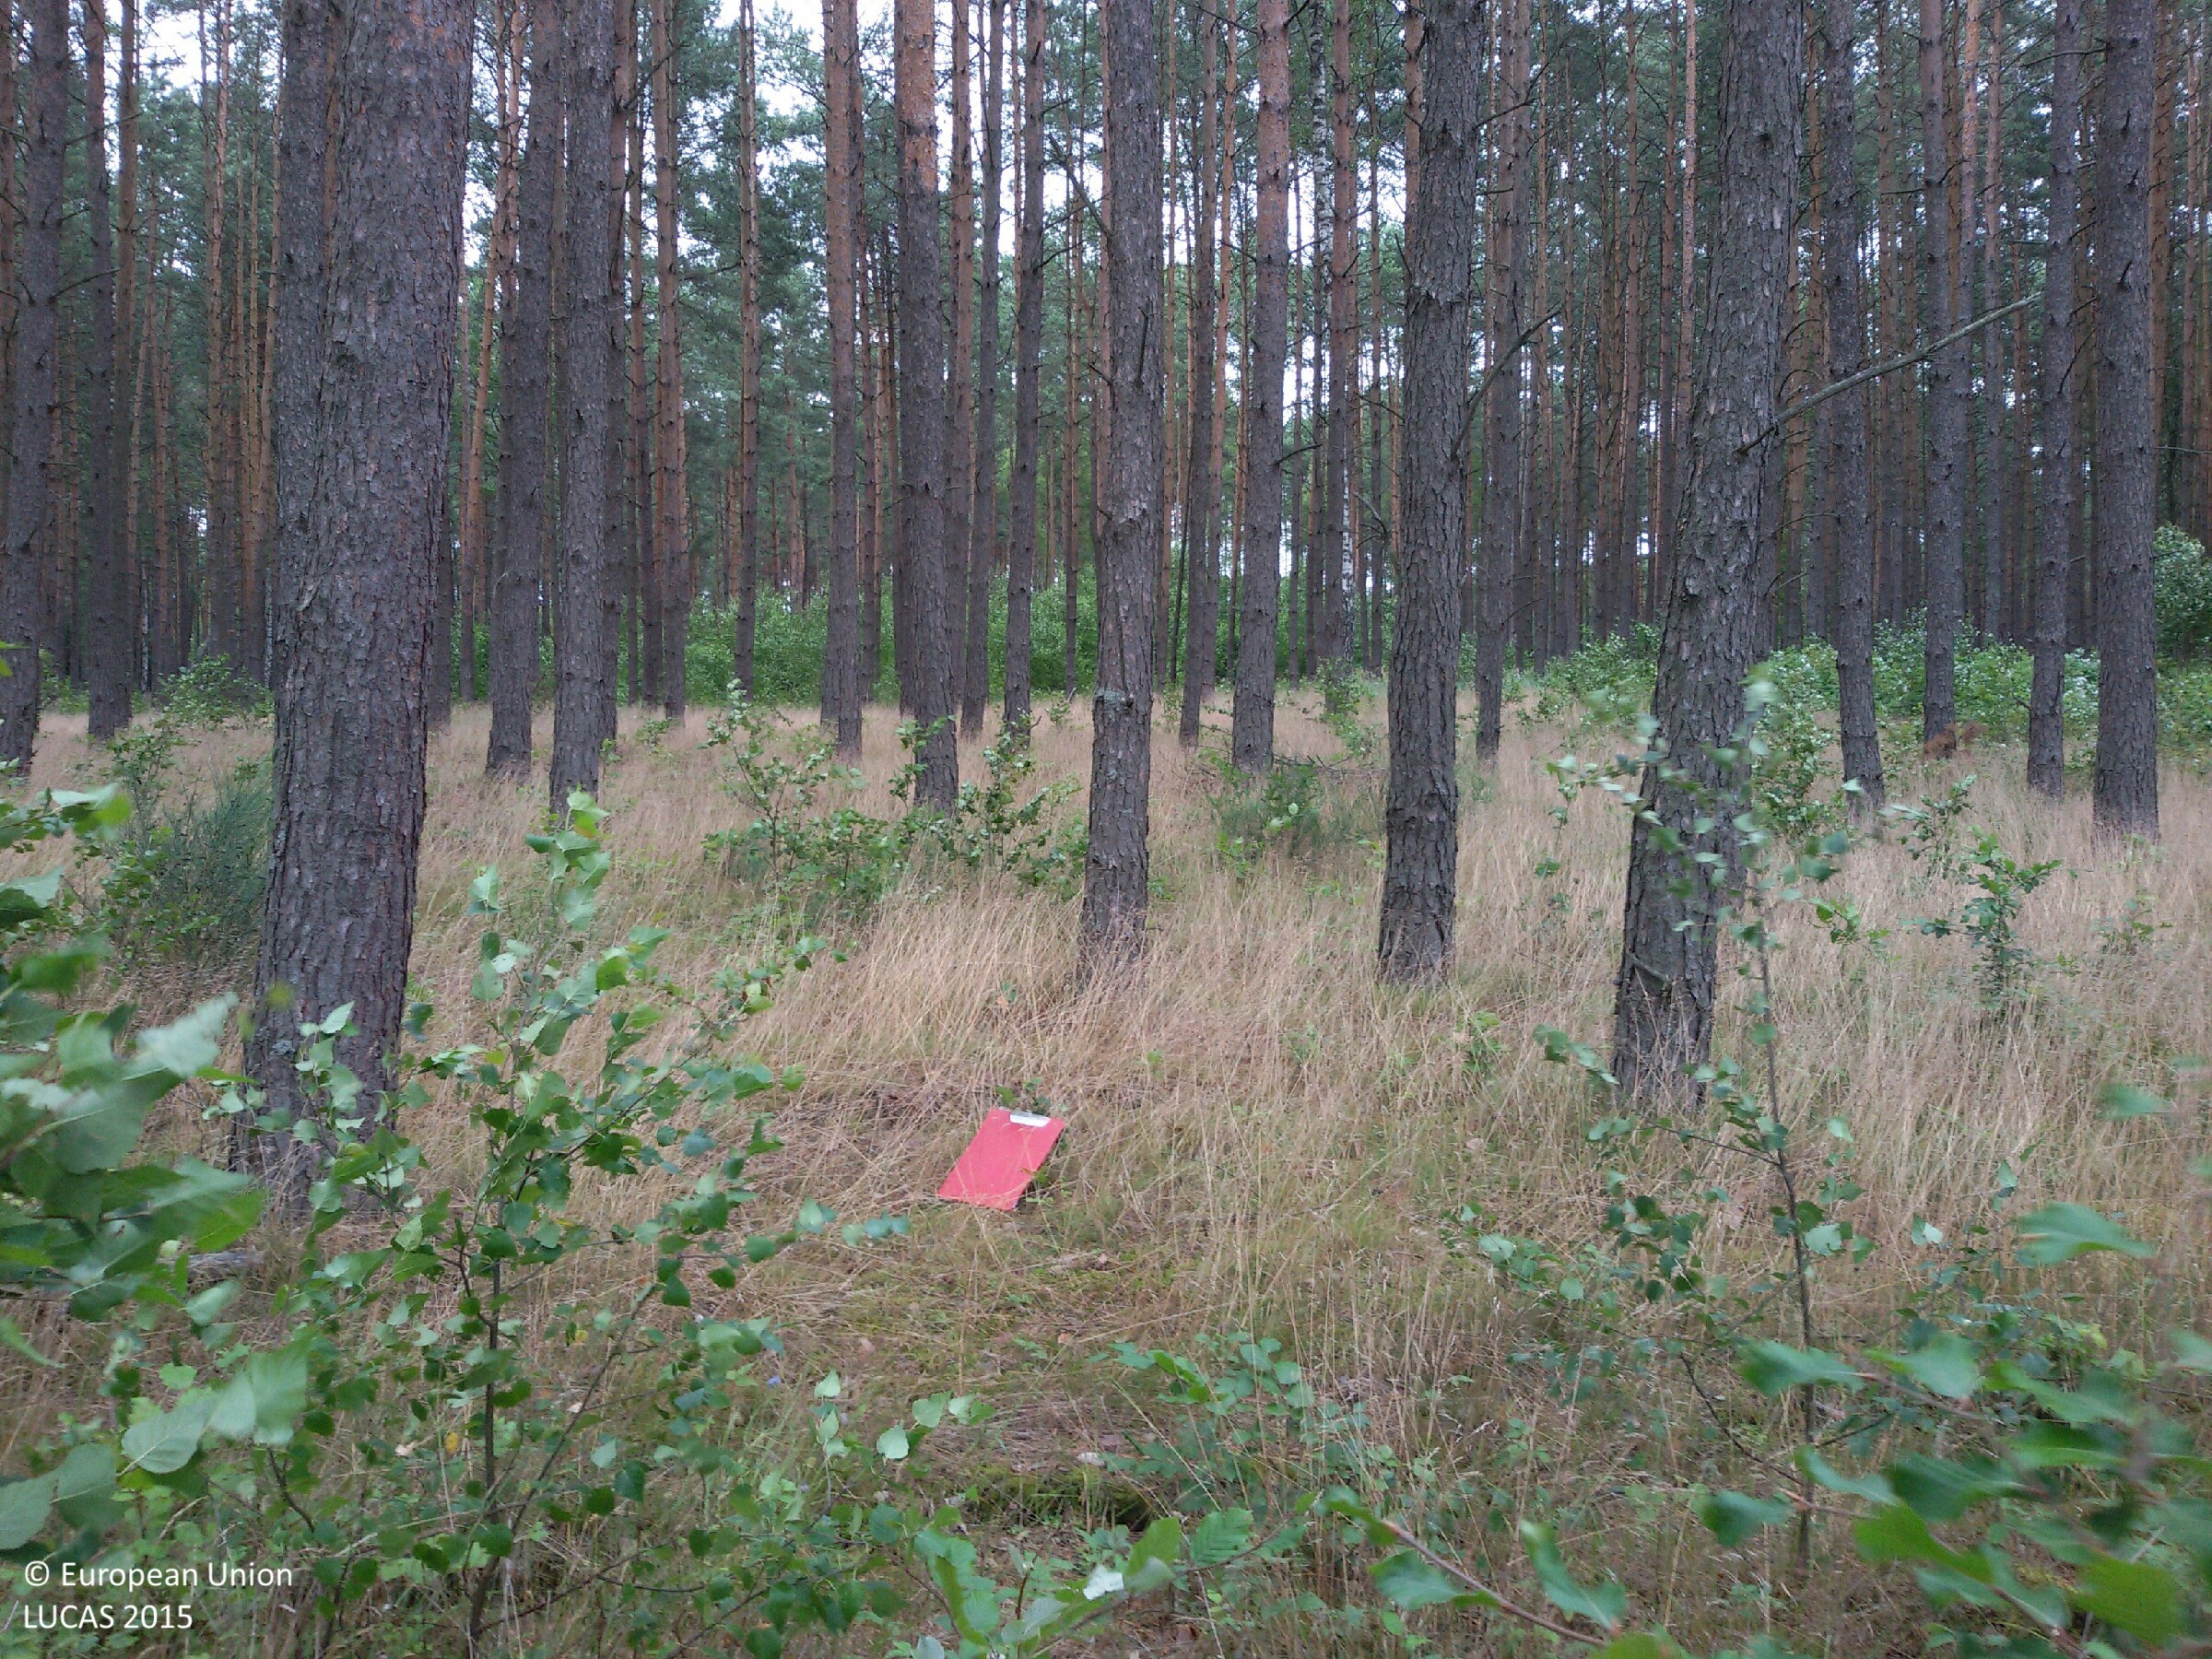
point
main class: Woodland
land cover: Pine dominated coniferous woodland
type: hemiboreal forest and nemoral coniferous forest and mixed broadleaved-coniferous forest
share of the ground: > 75 %
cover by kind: coniferous forest trees 85 %, herbaceous plants 10 %, broadleaved forest trees 5 %
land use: Forestry
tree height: > 5 m
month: July
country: PL
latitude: 53.1493
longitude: 16.2711
